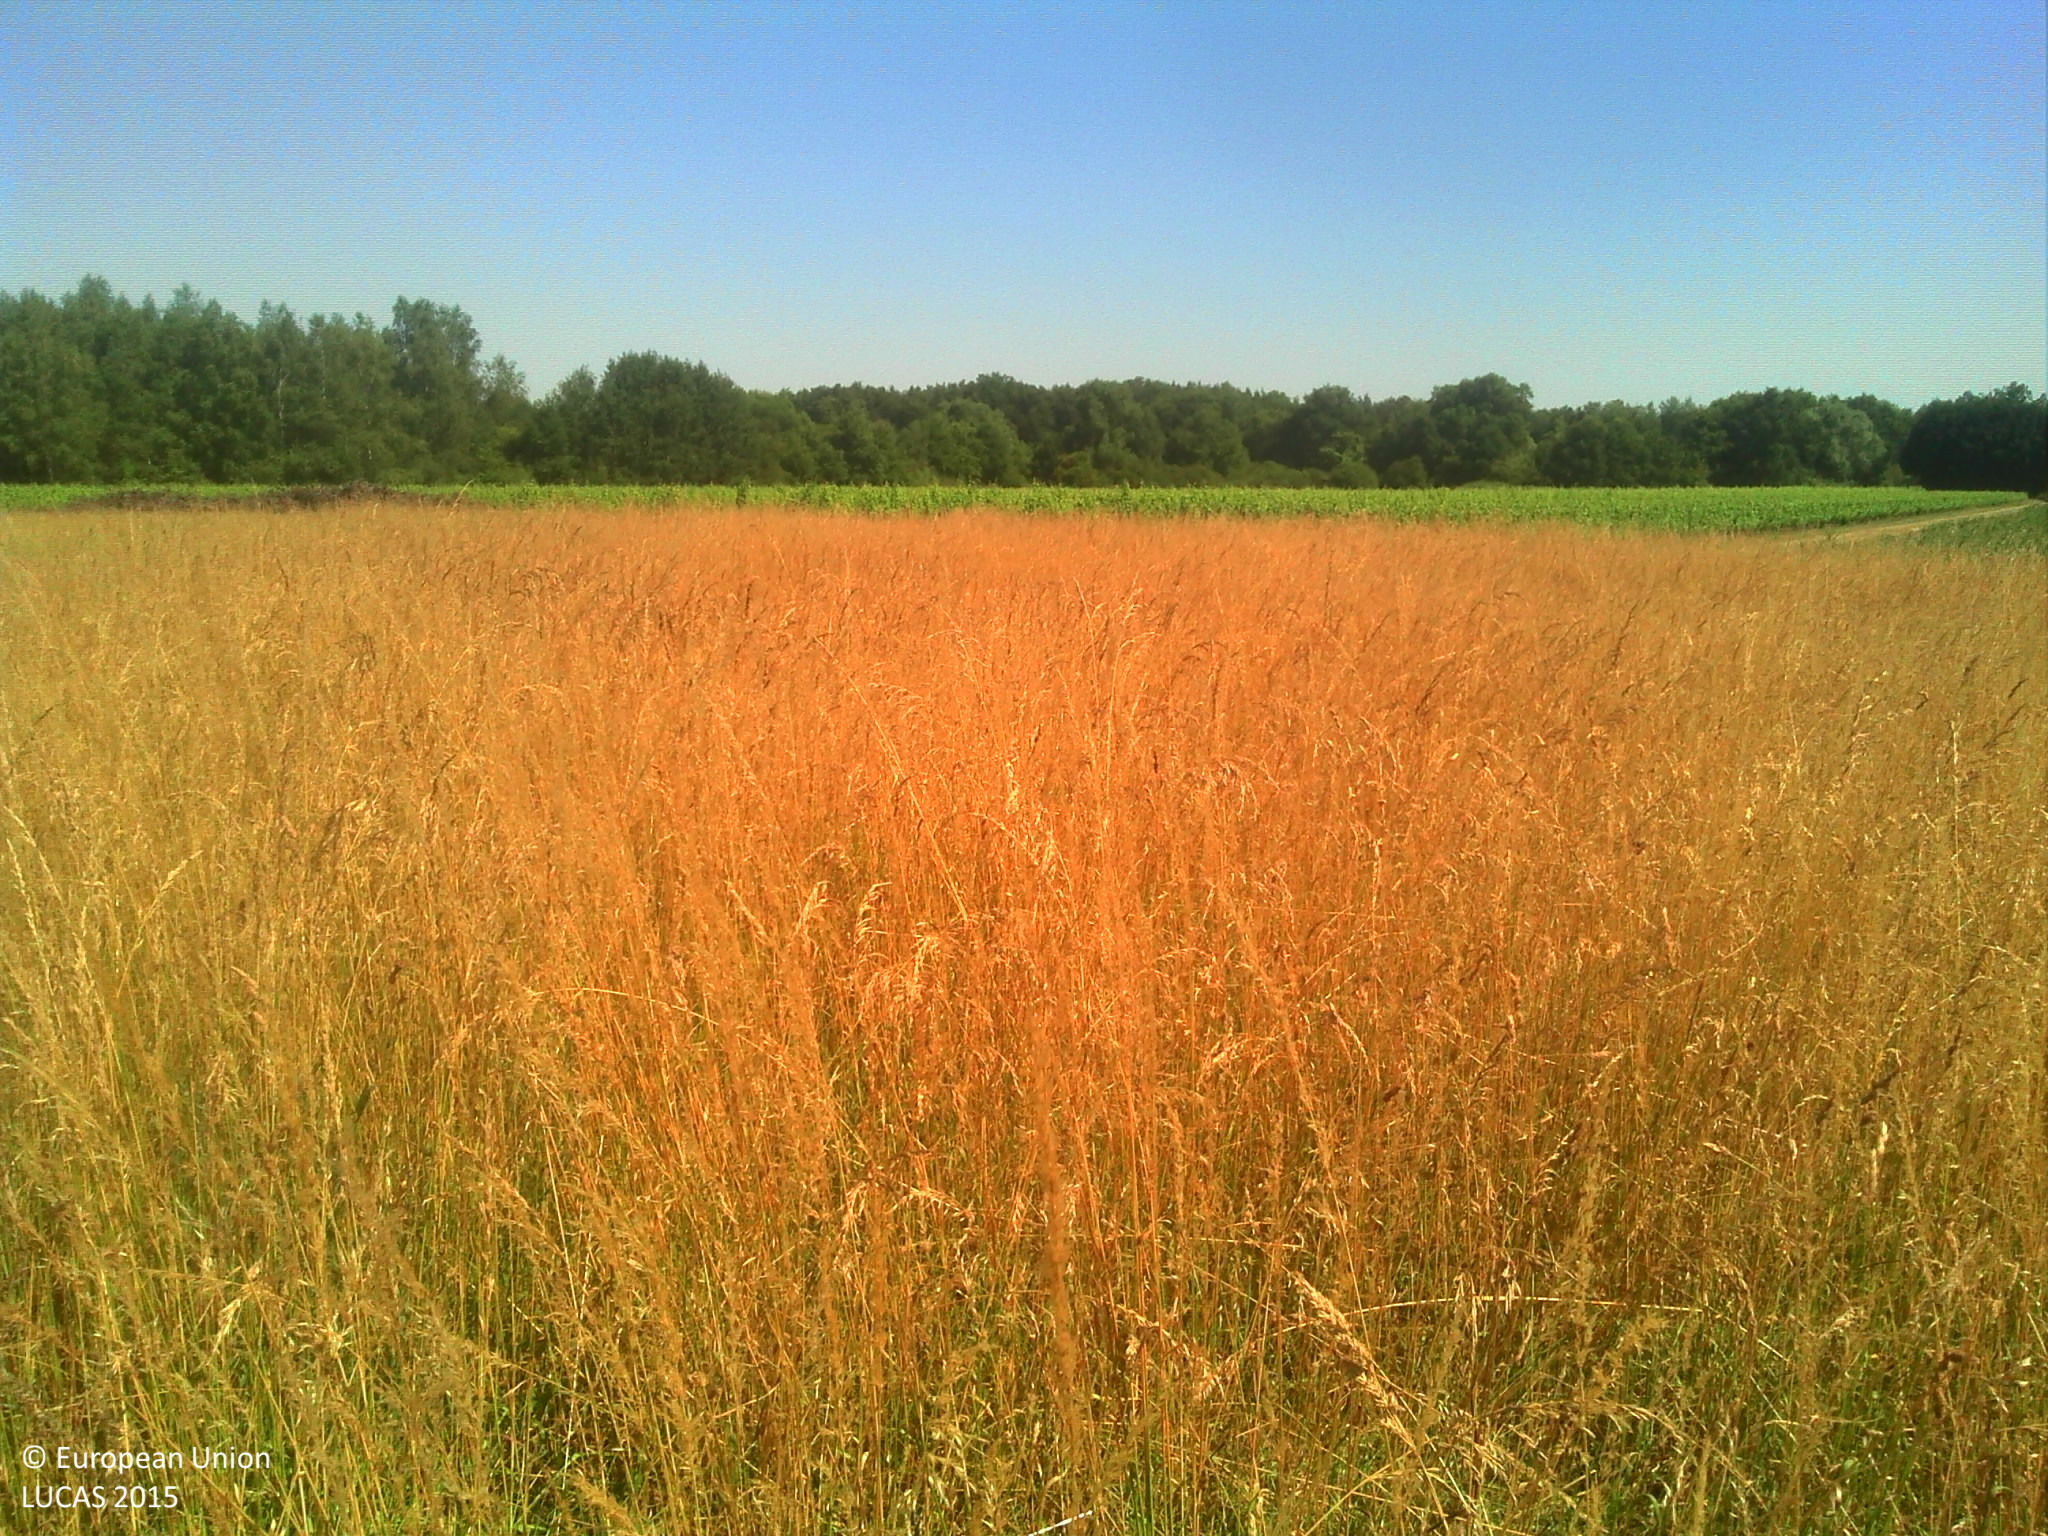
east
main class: Grassland
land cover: Grassland without tree/shrub cover
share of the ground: > 75 %
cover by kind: herbaceous plants 100 %
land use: Agriculture (excluding fallow land and kitchen gardens)
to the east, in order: Grassland without tree/shrub cover; Vineyards; Grassland without tree/shrub cover; Broadleaved woodland; Spontaneously vegetated surfaces; Shrubland without tree cover
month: June
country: FR
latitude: 47.3458
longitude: 1.4221
